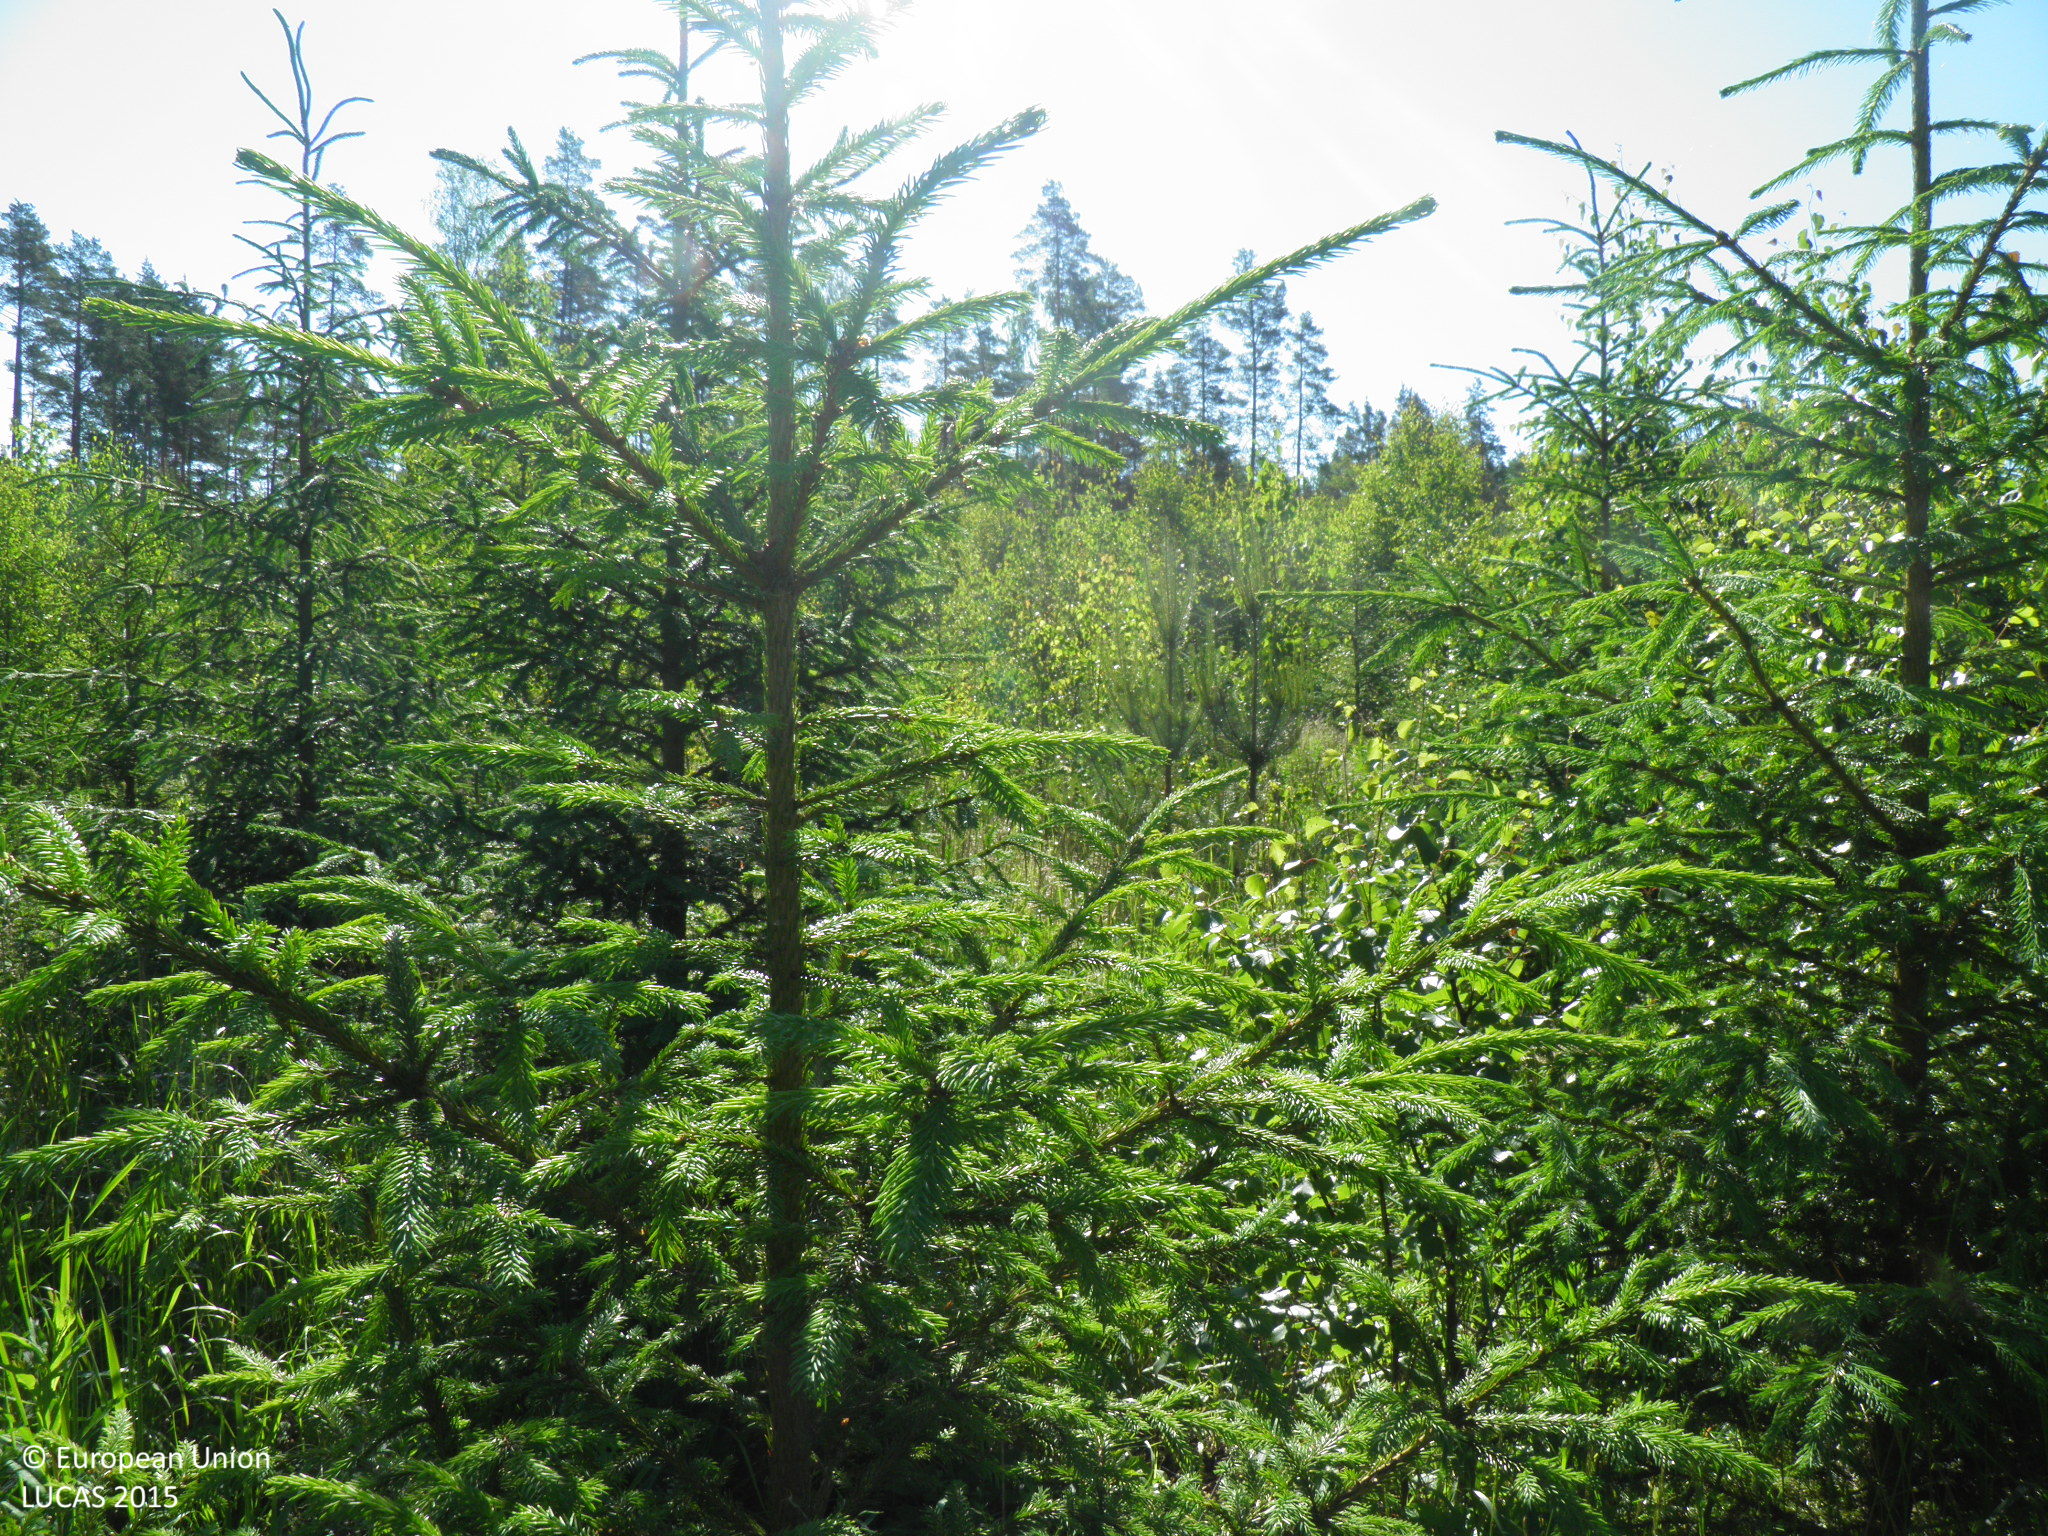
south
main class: Woodland
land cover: Other mixed woodland
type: hemiboreal forest and nemoral coniferous forest and mixed broadleaved-coniferous forest
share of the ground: 50 - 75 %
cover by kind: broadleaved forest trees 55 %, coniferous forest trees 20 %, herbaceous plants 15 %, shrubs 10 %
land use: Forestry
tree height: < 5 m
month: July
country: FI
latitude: 60.5256
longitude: 22.8105
